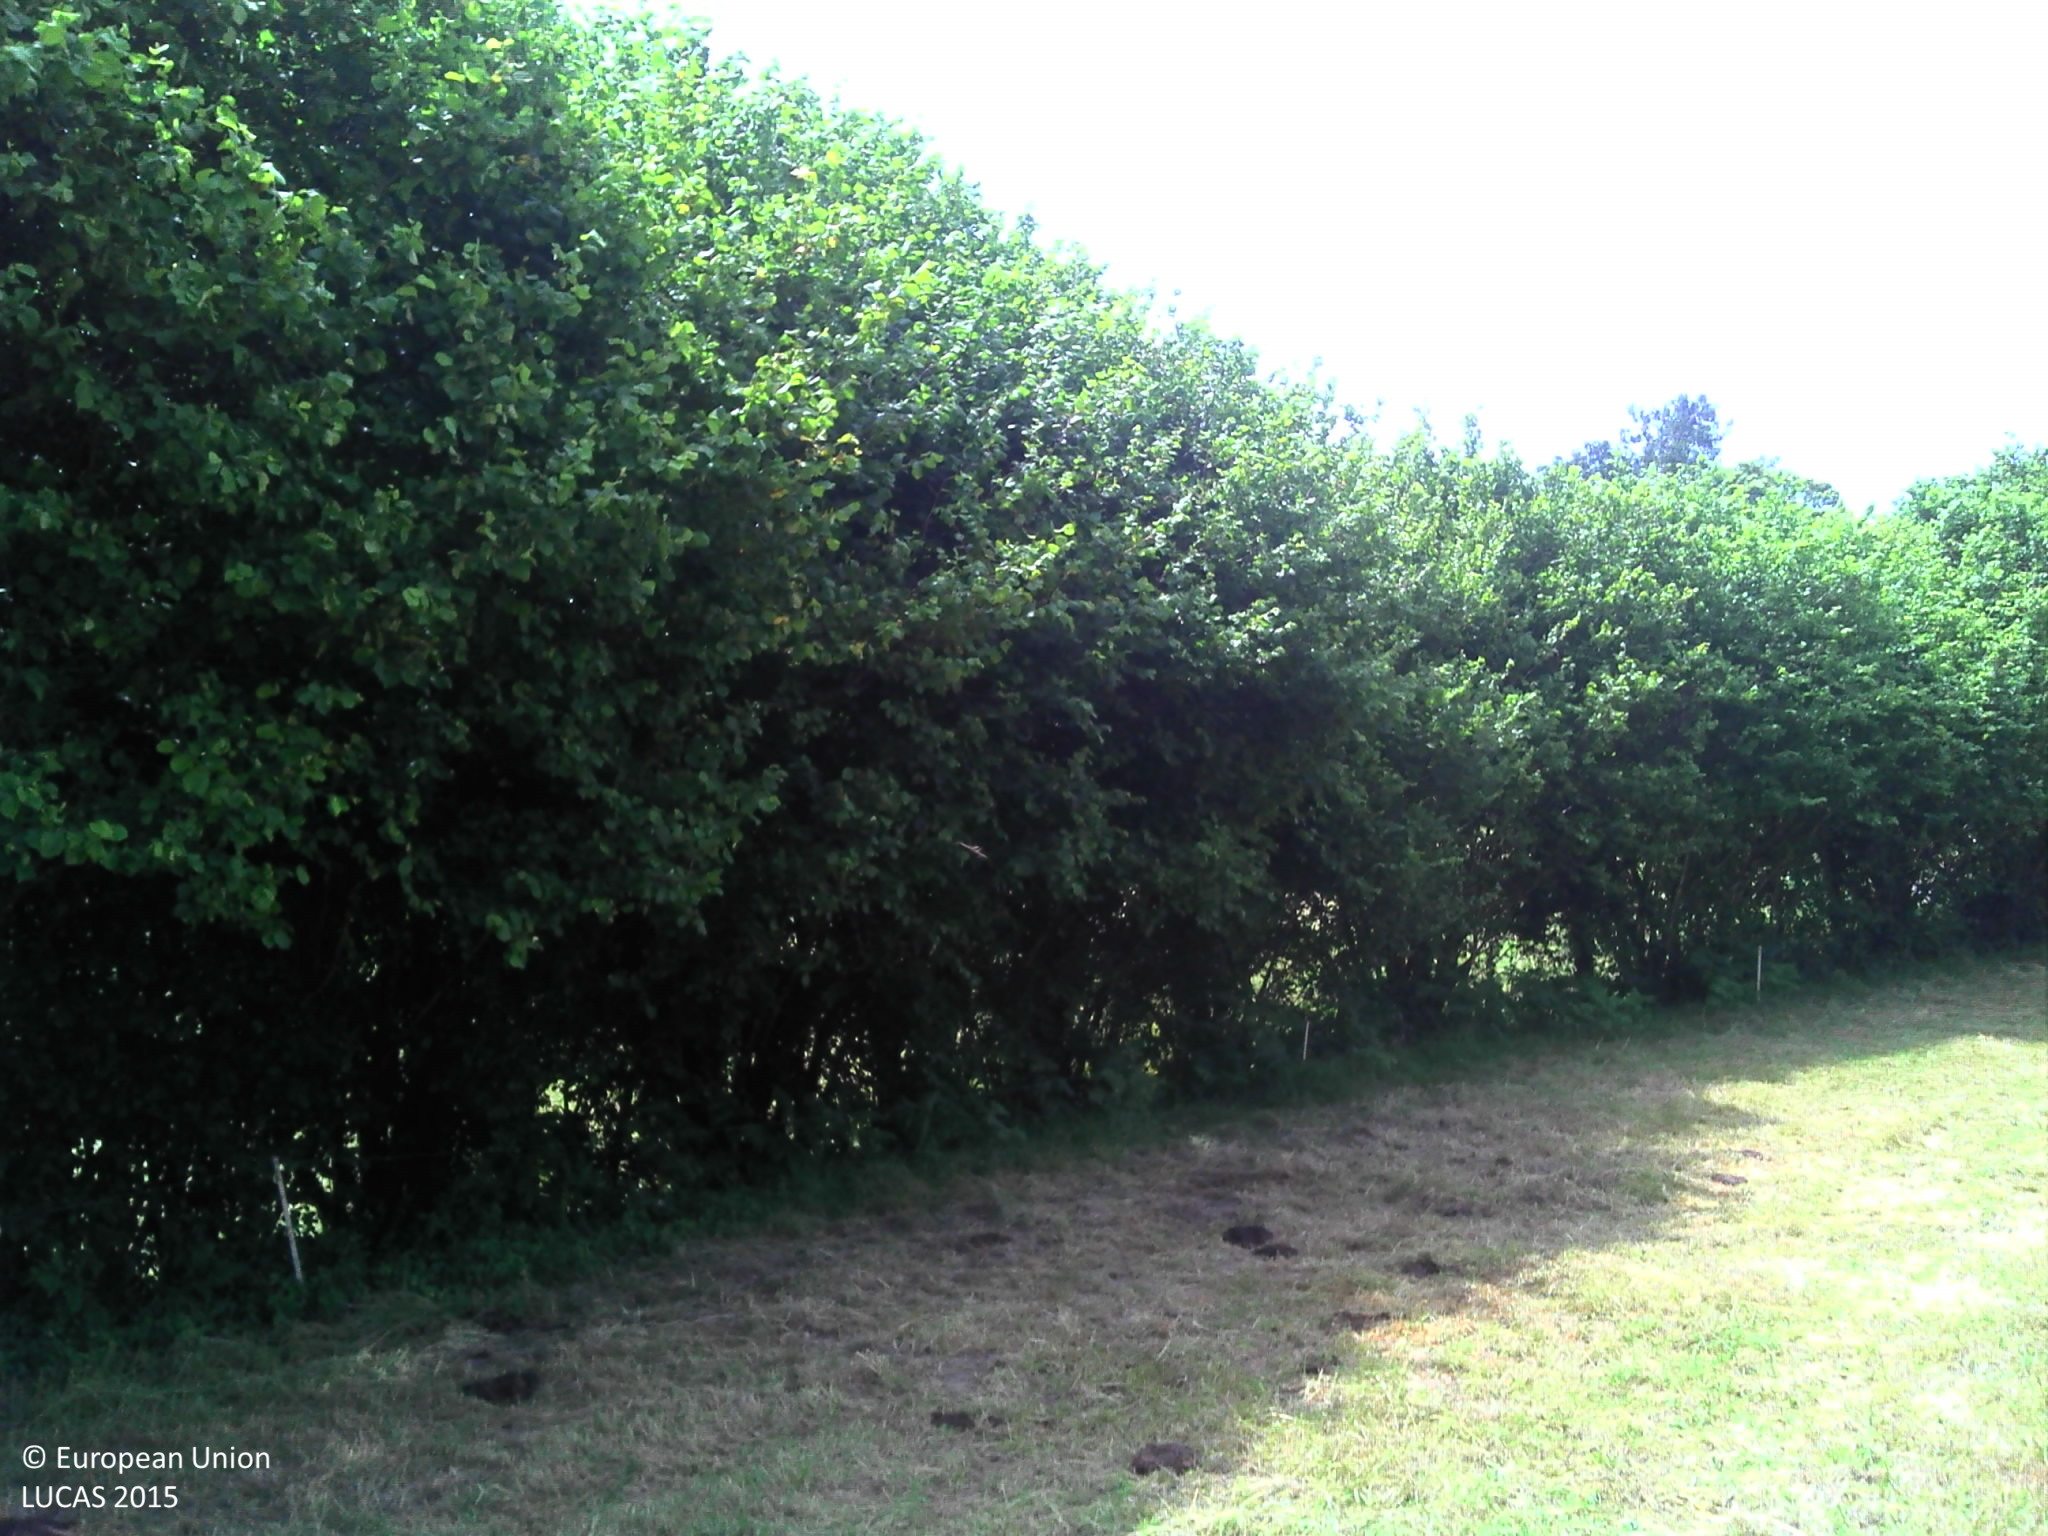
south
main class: Grassland
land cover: Grassland without tree/shrub cover
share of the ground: > 75 %
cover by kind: herbaceous plants 100 %
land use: Agriculture (excluding fallow land and kitchen gardens)
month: June
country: FR
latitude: 46.9559
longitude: 3.9412
